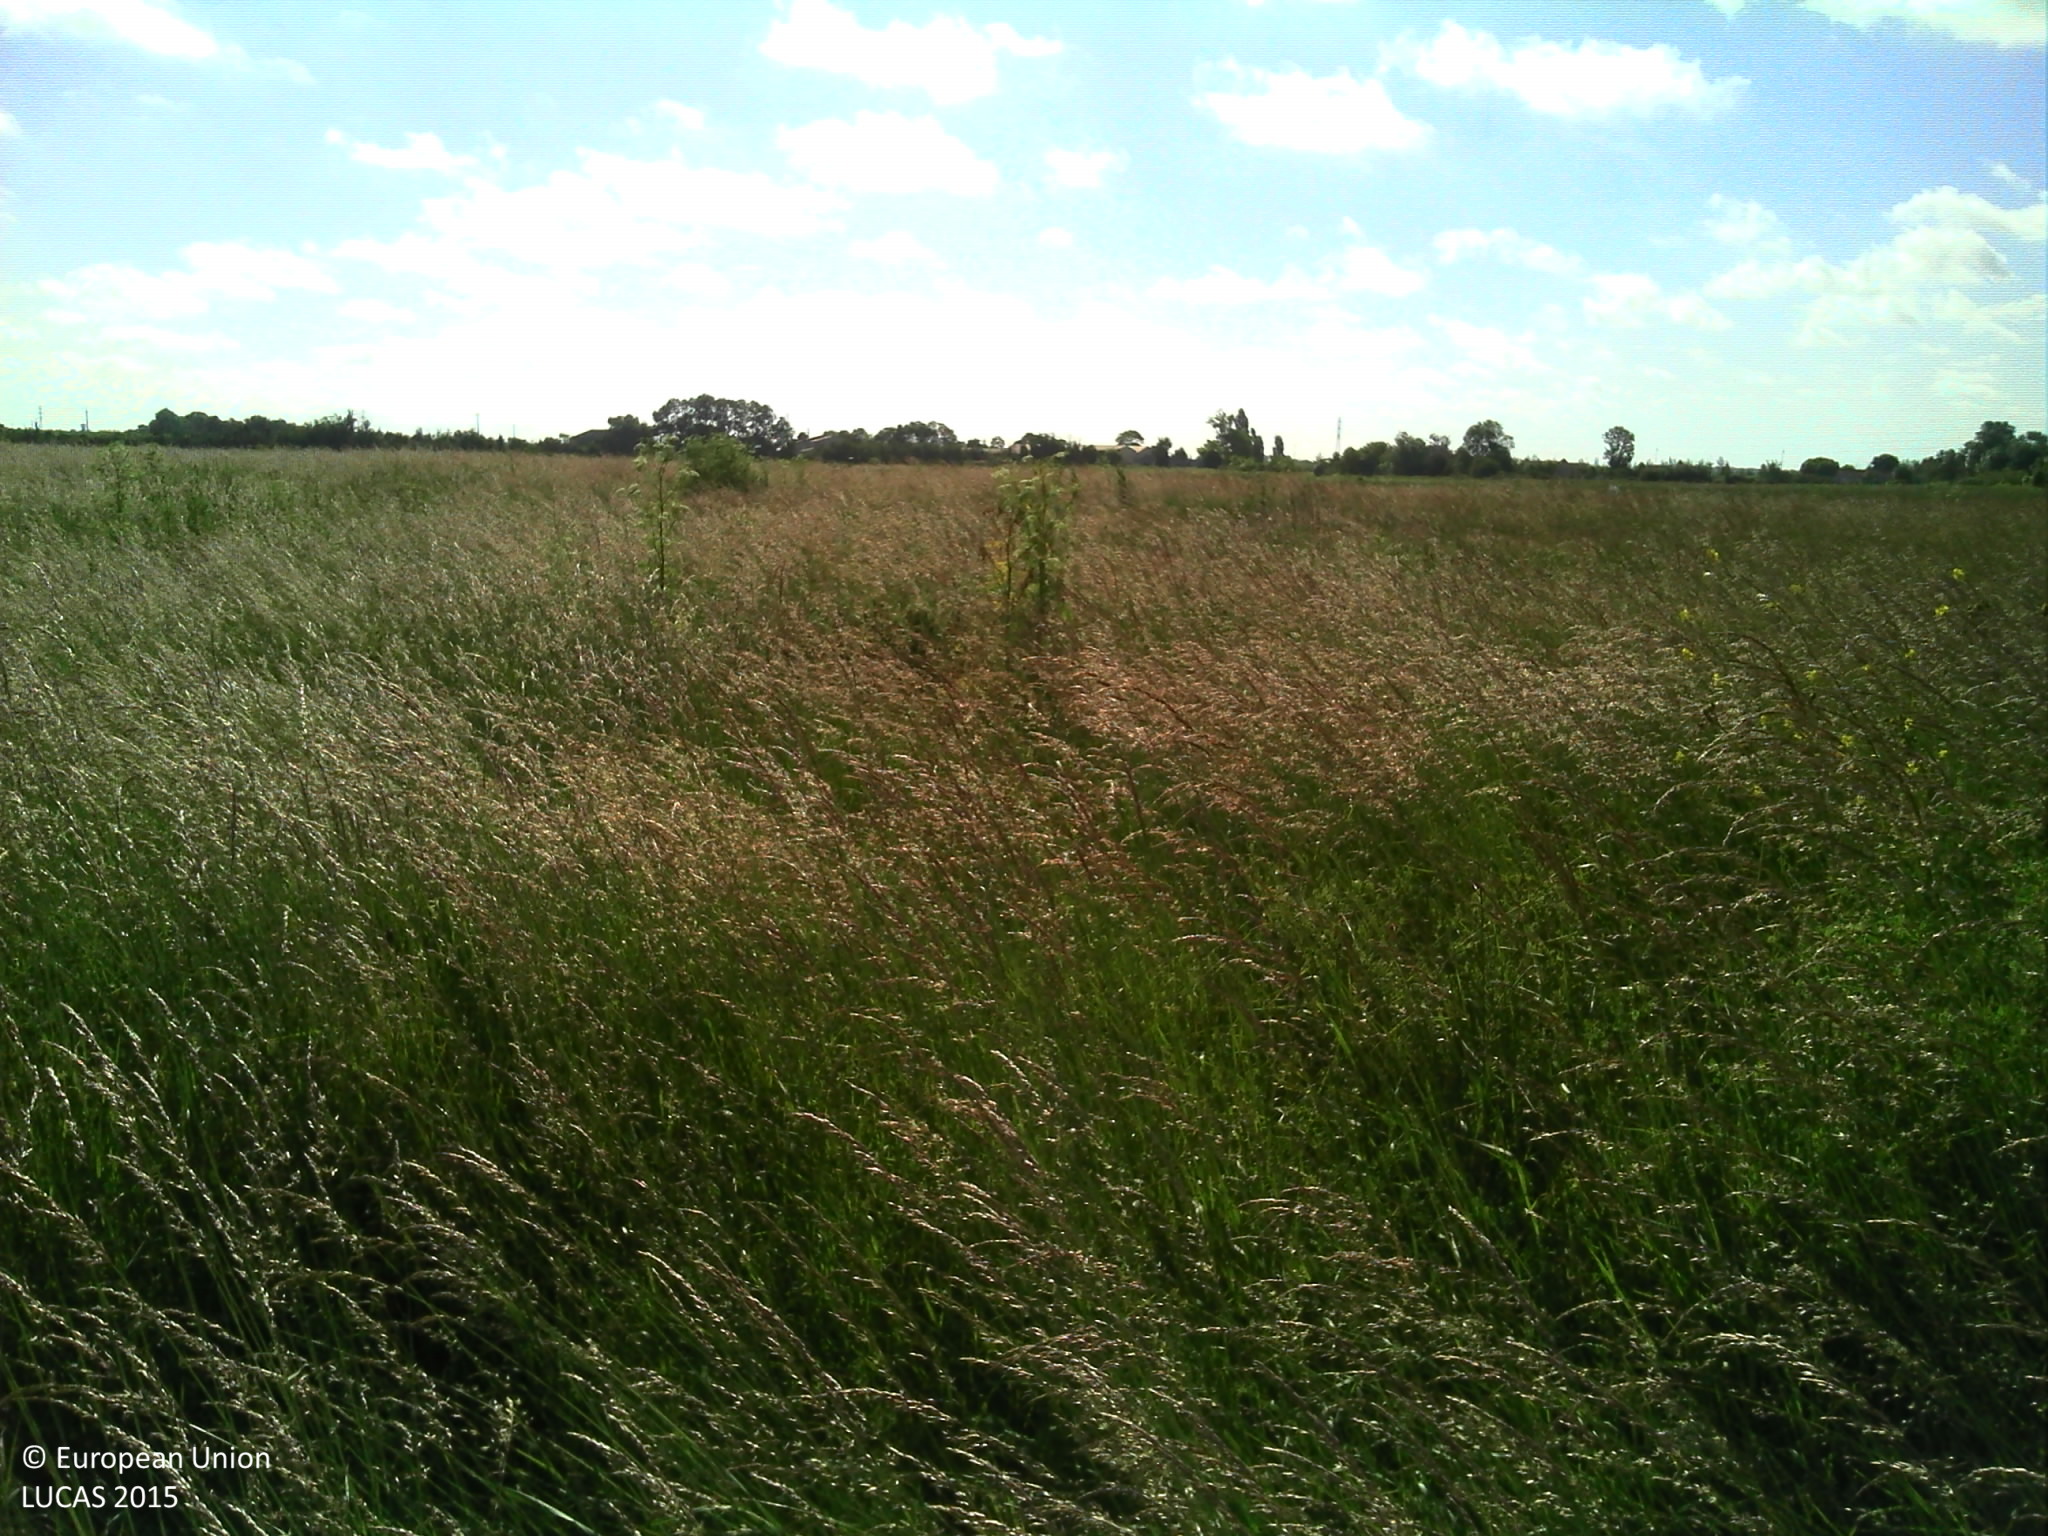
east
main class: Grassland
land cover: Grassland without tree/shrub cover
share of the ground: > 75 %
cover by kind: herbaceous plants 100 %
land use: Agriculture (excluding fallow land and kitchen gardens)
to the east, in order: Grassland without tree/shrub cover; Tracks; Spontaneously vegetated surfaces; Sunflower; Ditches and canals; Sunflower; Ditches and canals; Common wheat; Ditches and canals
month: June
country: FR
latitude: 46.2473
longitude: -1.0691
